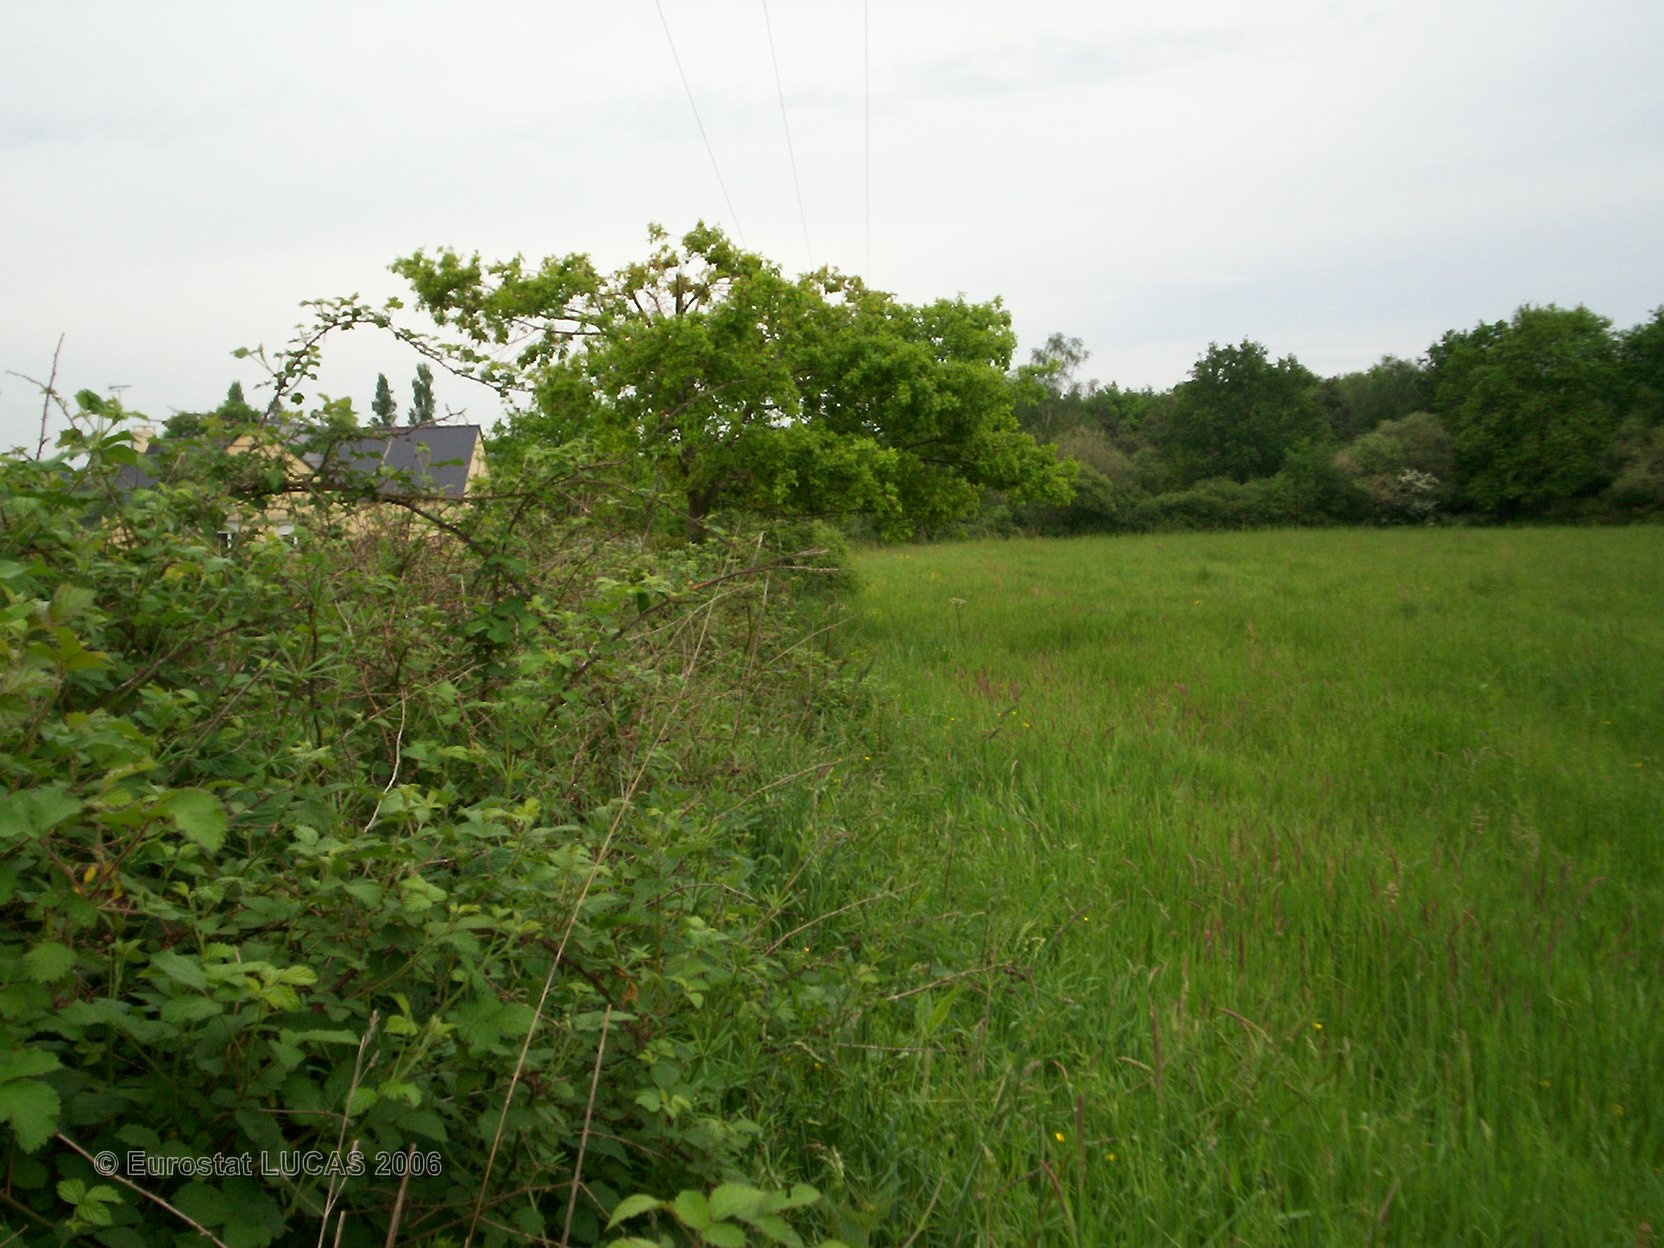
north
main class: Grassland
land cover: Grassland without tree/shrub cover
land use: Agriculture (excluding fallow land and kitchen gardens)
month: May
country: FR
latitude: 47.4563
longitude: -2.1619
